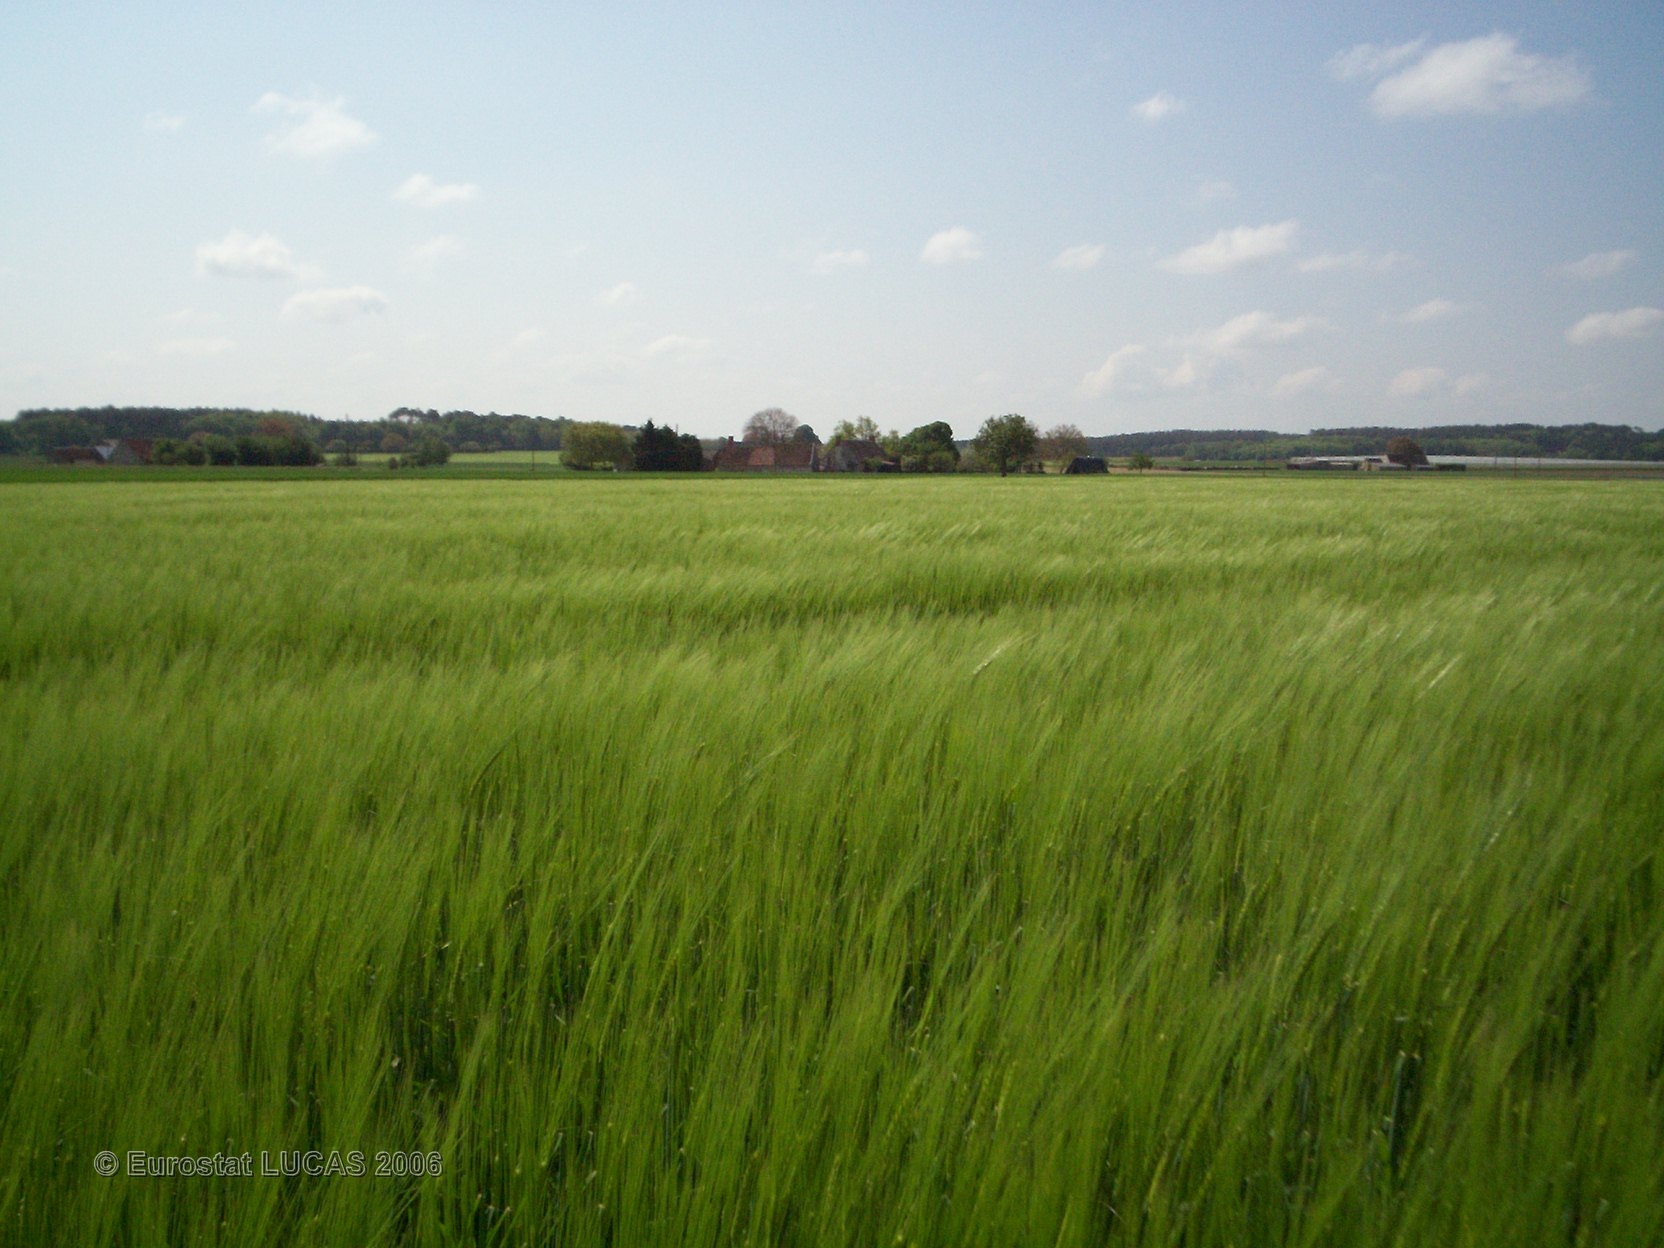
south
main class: Cropland
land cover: Barley
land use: Agriculture (excluding fallow land and kitchen gardens)
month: May
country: FR
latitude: 47.4014
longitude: 0.1573
